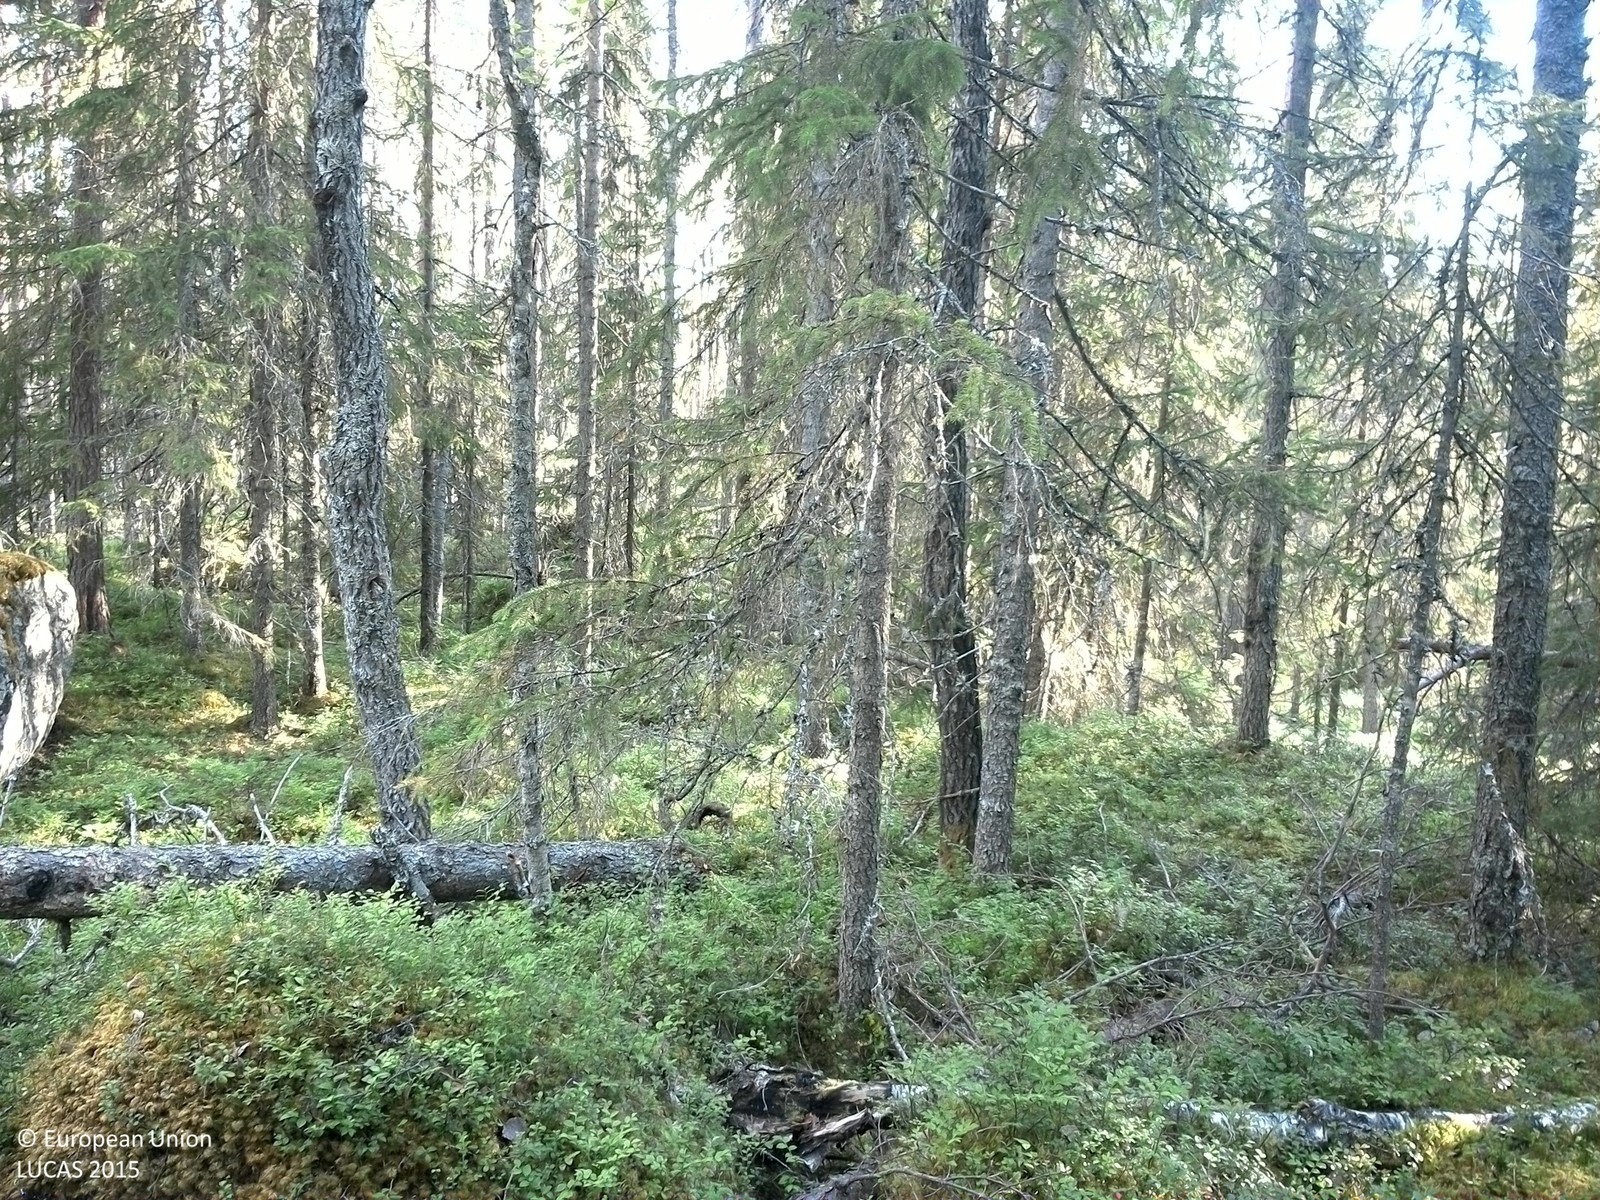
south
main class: Woodland
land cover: Pine dominated coniferous woodland
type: boreal forest
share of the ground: 50 - 75 %
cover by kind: coniferous forest trees 50 %, shrubs 35 %, lichens and mosses 15 %
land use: Forestry
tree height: > 5 m
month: August
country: SE
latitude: 63.6361
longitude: 16.3714
